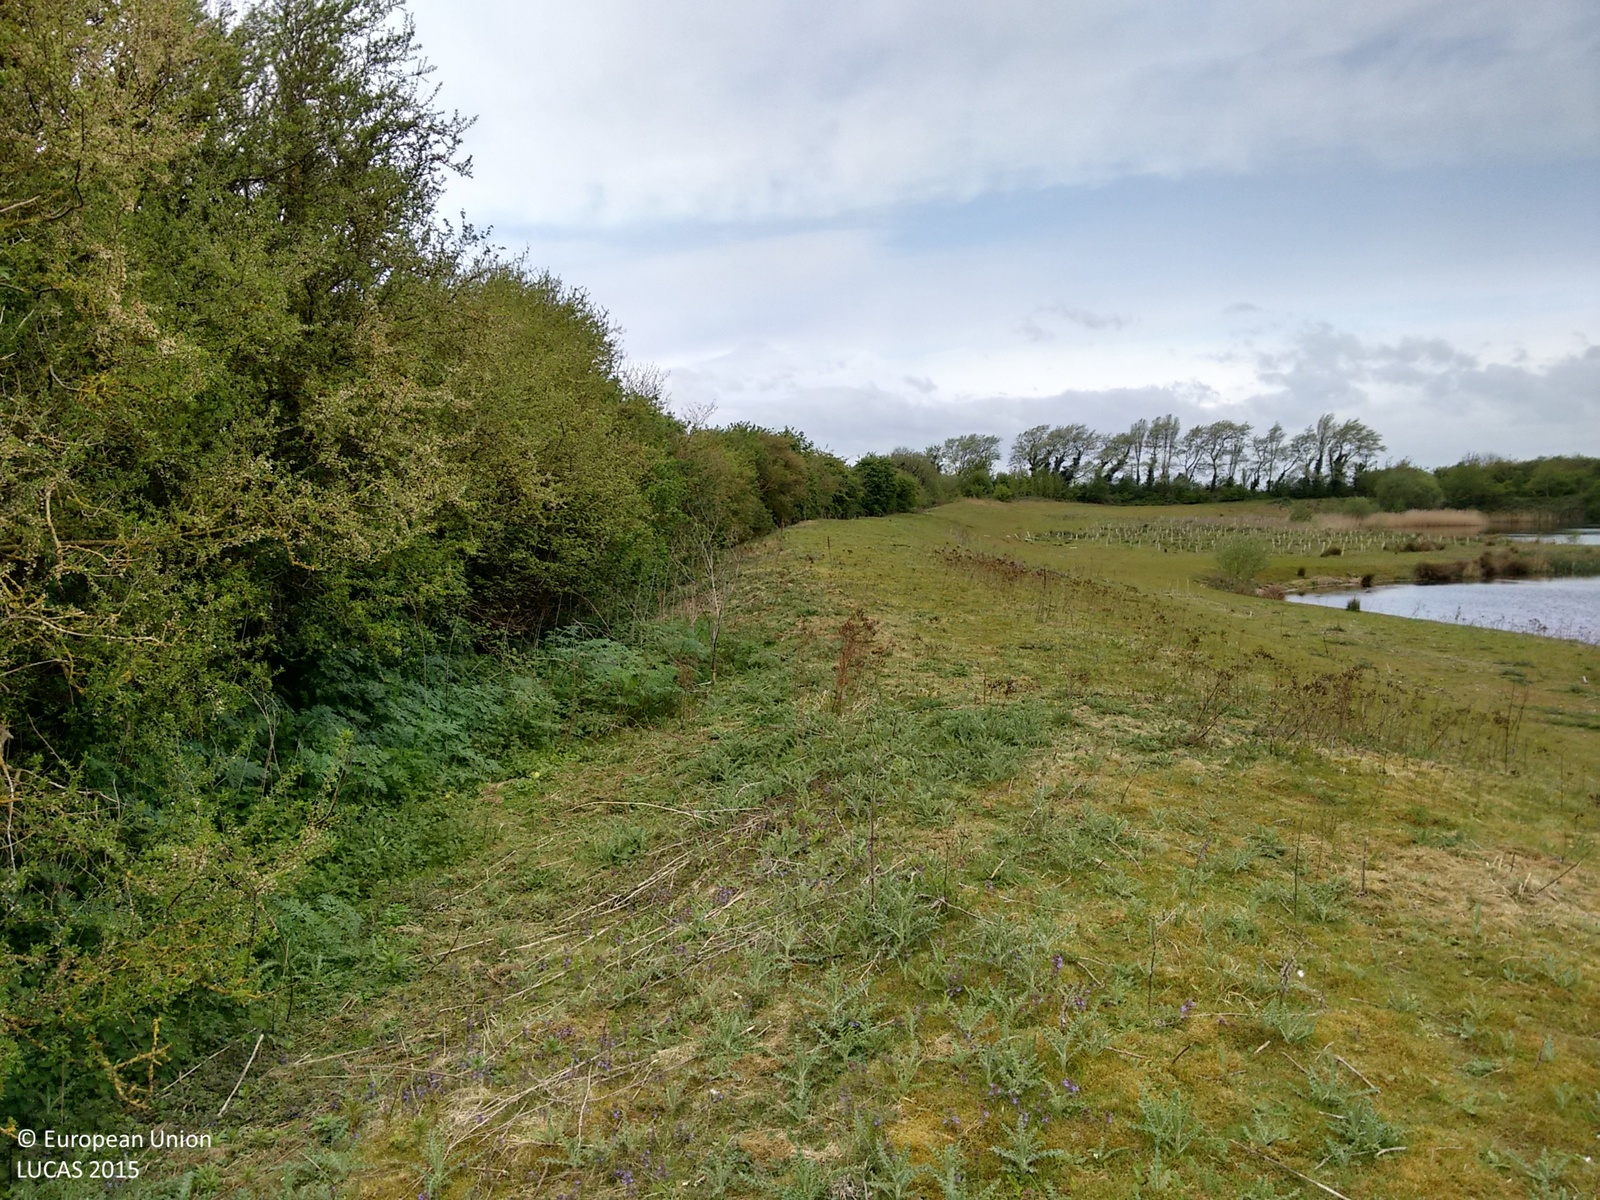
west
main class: Grassland
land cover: Grassland without tree/shrub cover
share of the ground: > 75 %
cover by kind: herbaceous plants 100 %
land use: Amenities, museums, leisure
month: May
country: GB
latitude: 53.9036
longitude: -0.3083
